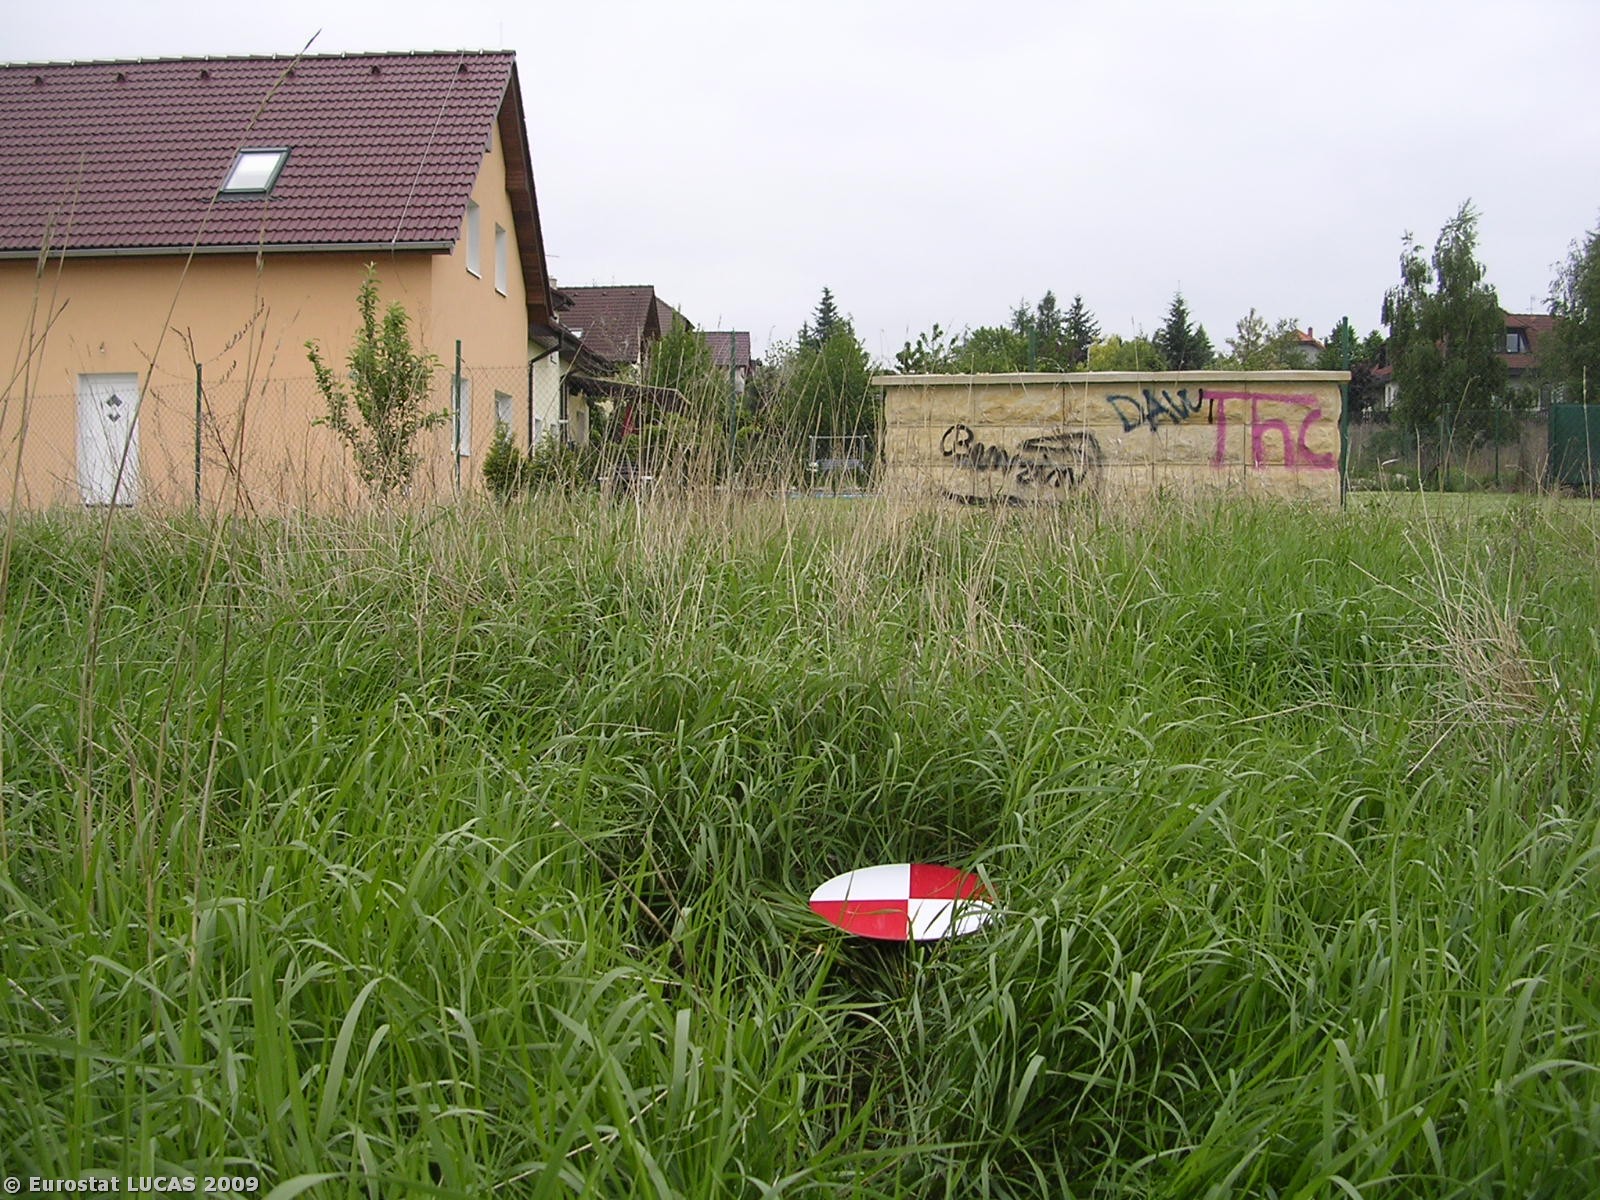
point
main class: Grassland
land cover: Grassland without tree/shrub cover
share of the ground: > 75 %
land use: Fallow land
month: May
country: CZ
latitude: 50.1060
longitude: 14.6860
